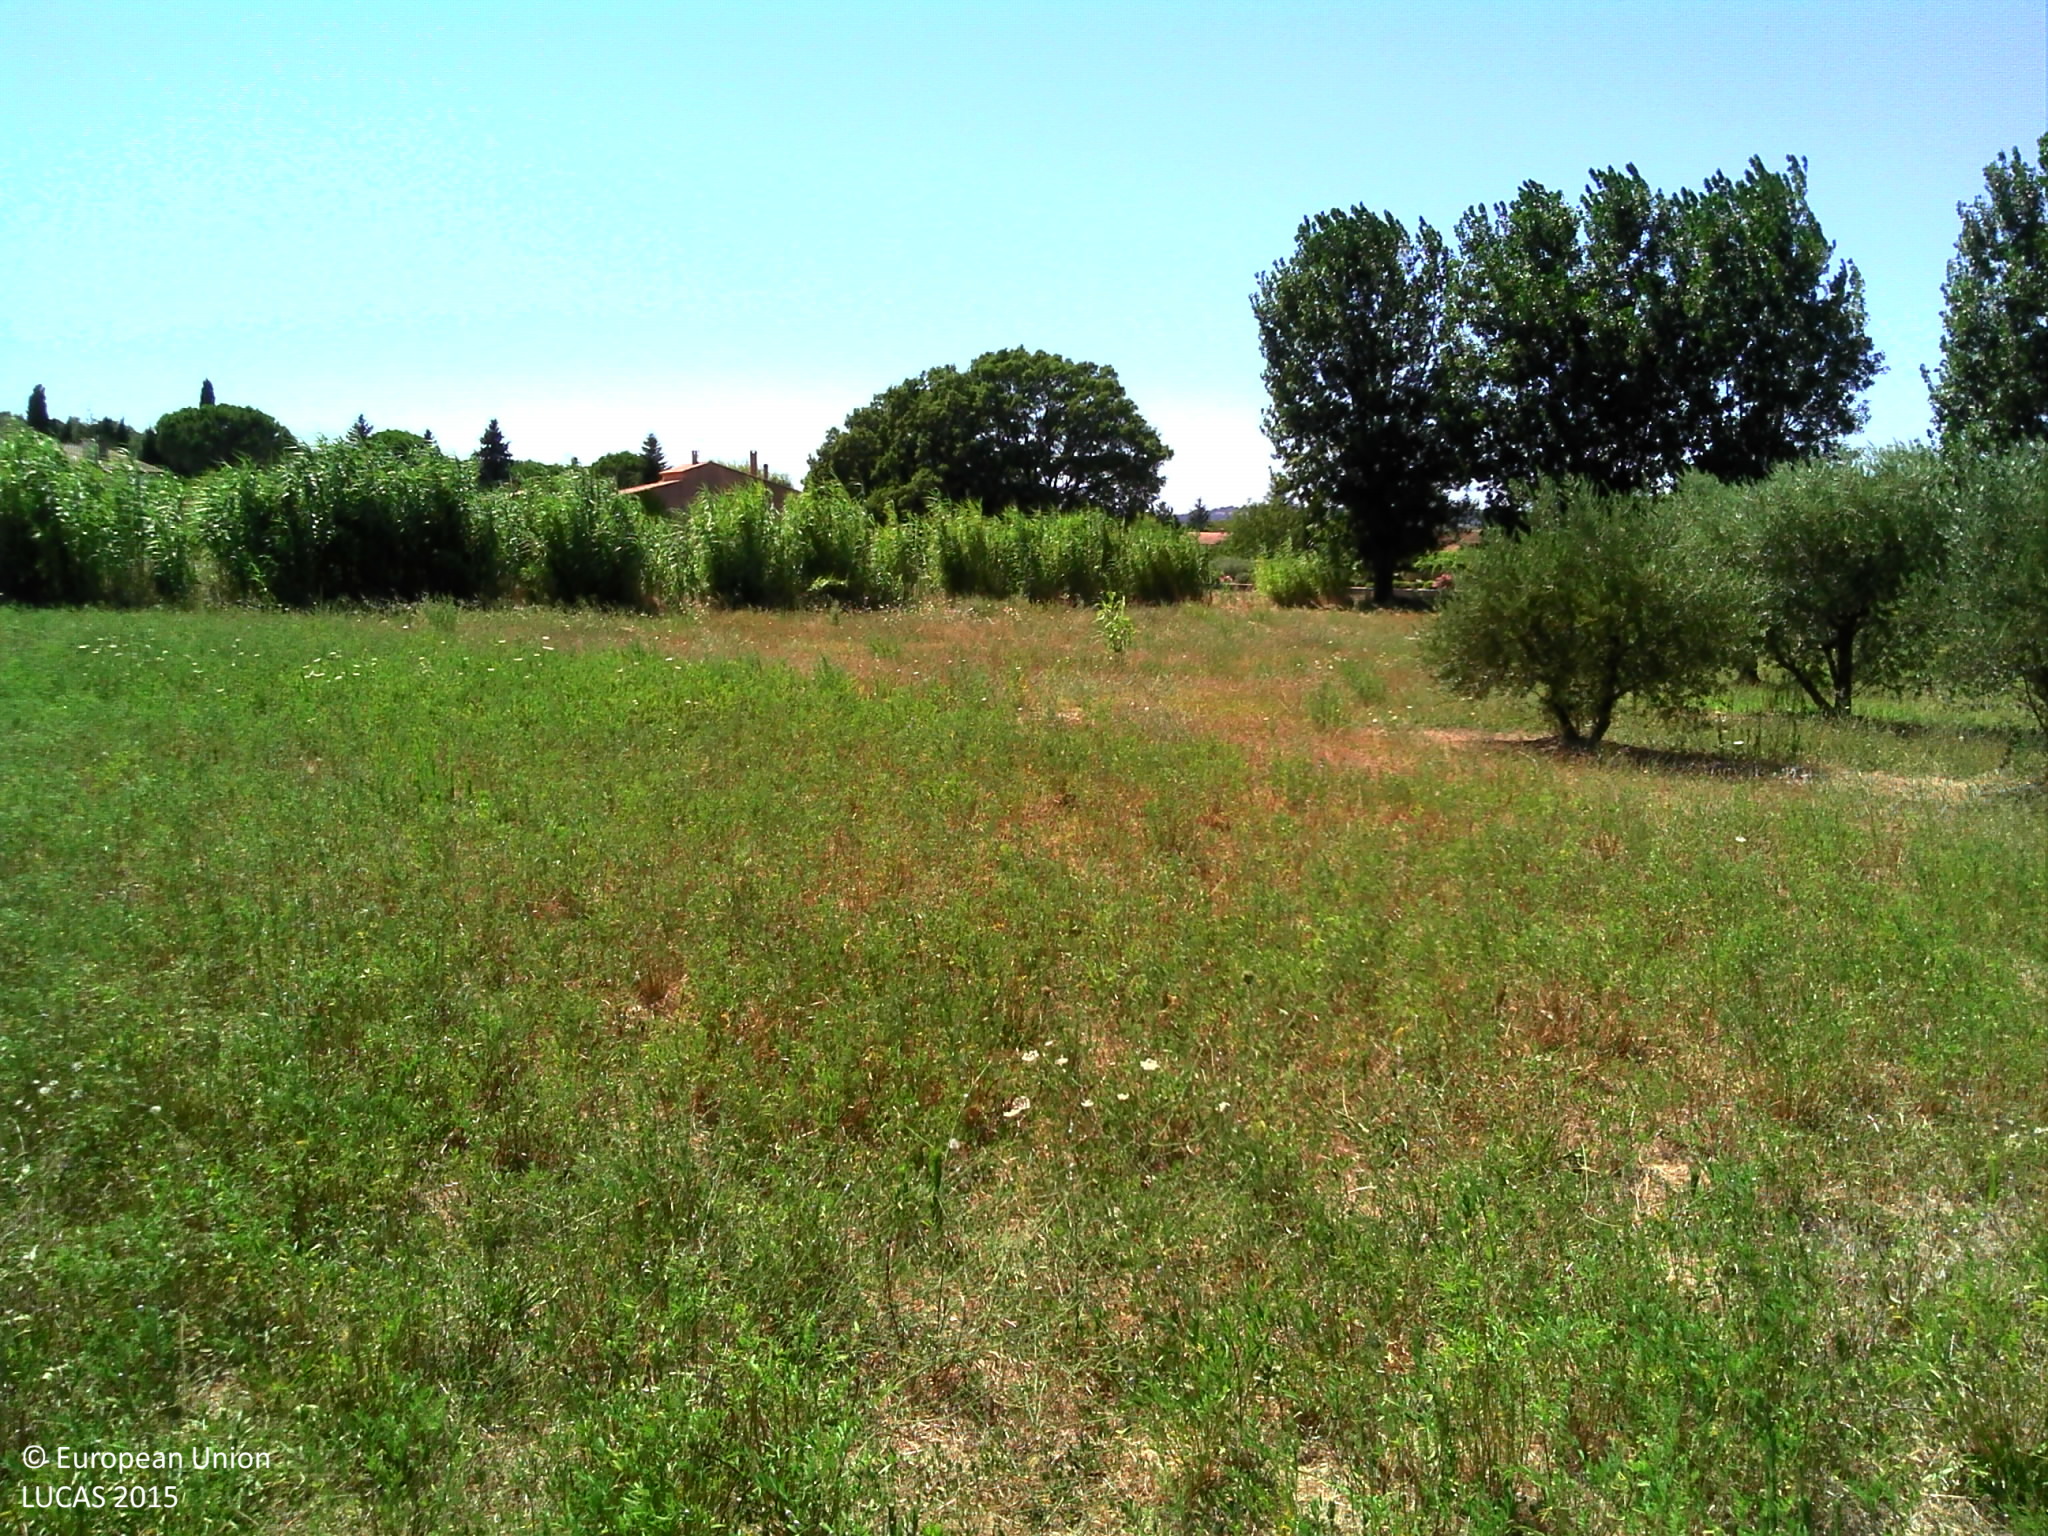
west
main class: Grassland
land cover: Grassland without tree/shrub cover
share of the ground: > 75 %
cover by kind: herbaceous plants 95 %, unconsolidated bare surface 5 %
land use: Agriculture (excluding fallow land and kitchen gardens)
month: July
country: FR
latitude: 43.8371
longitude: 5.0963
